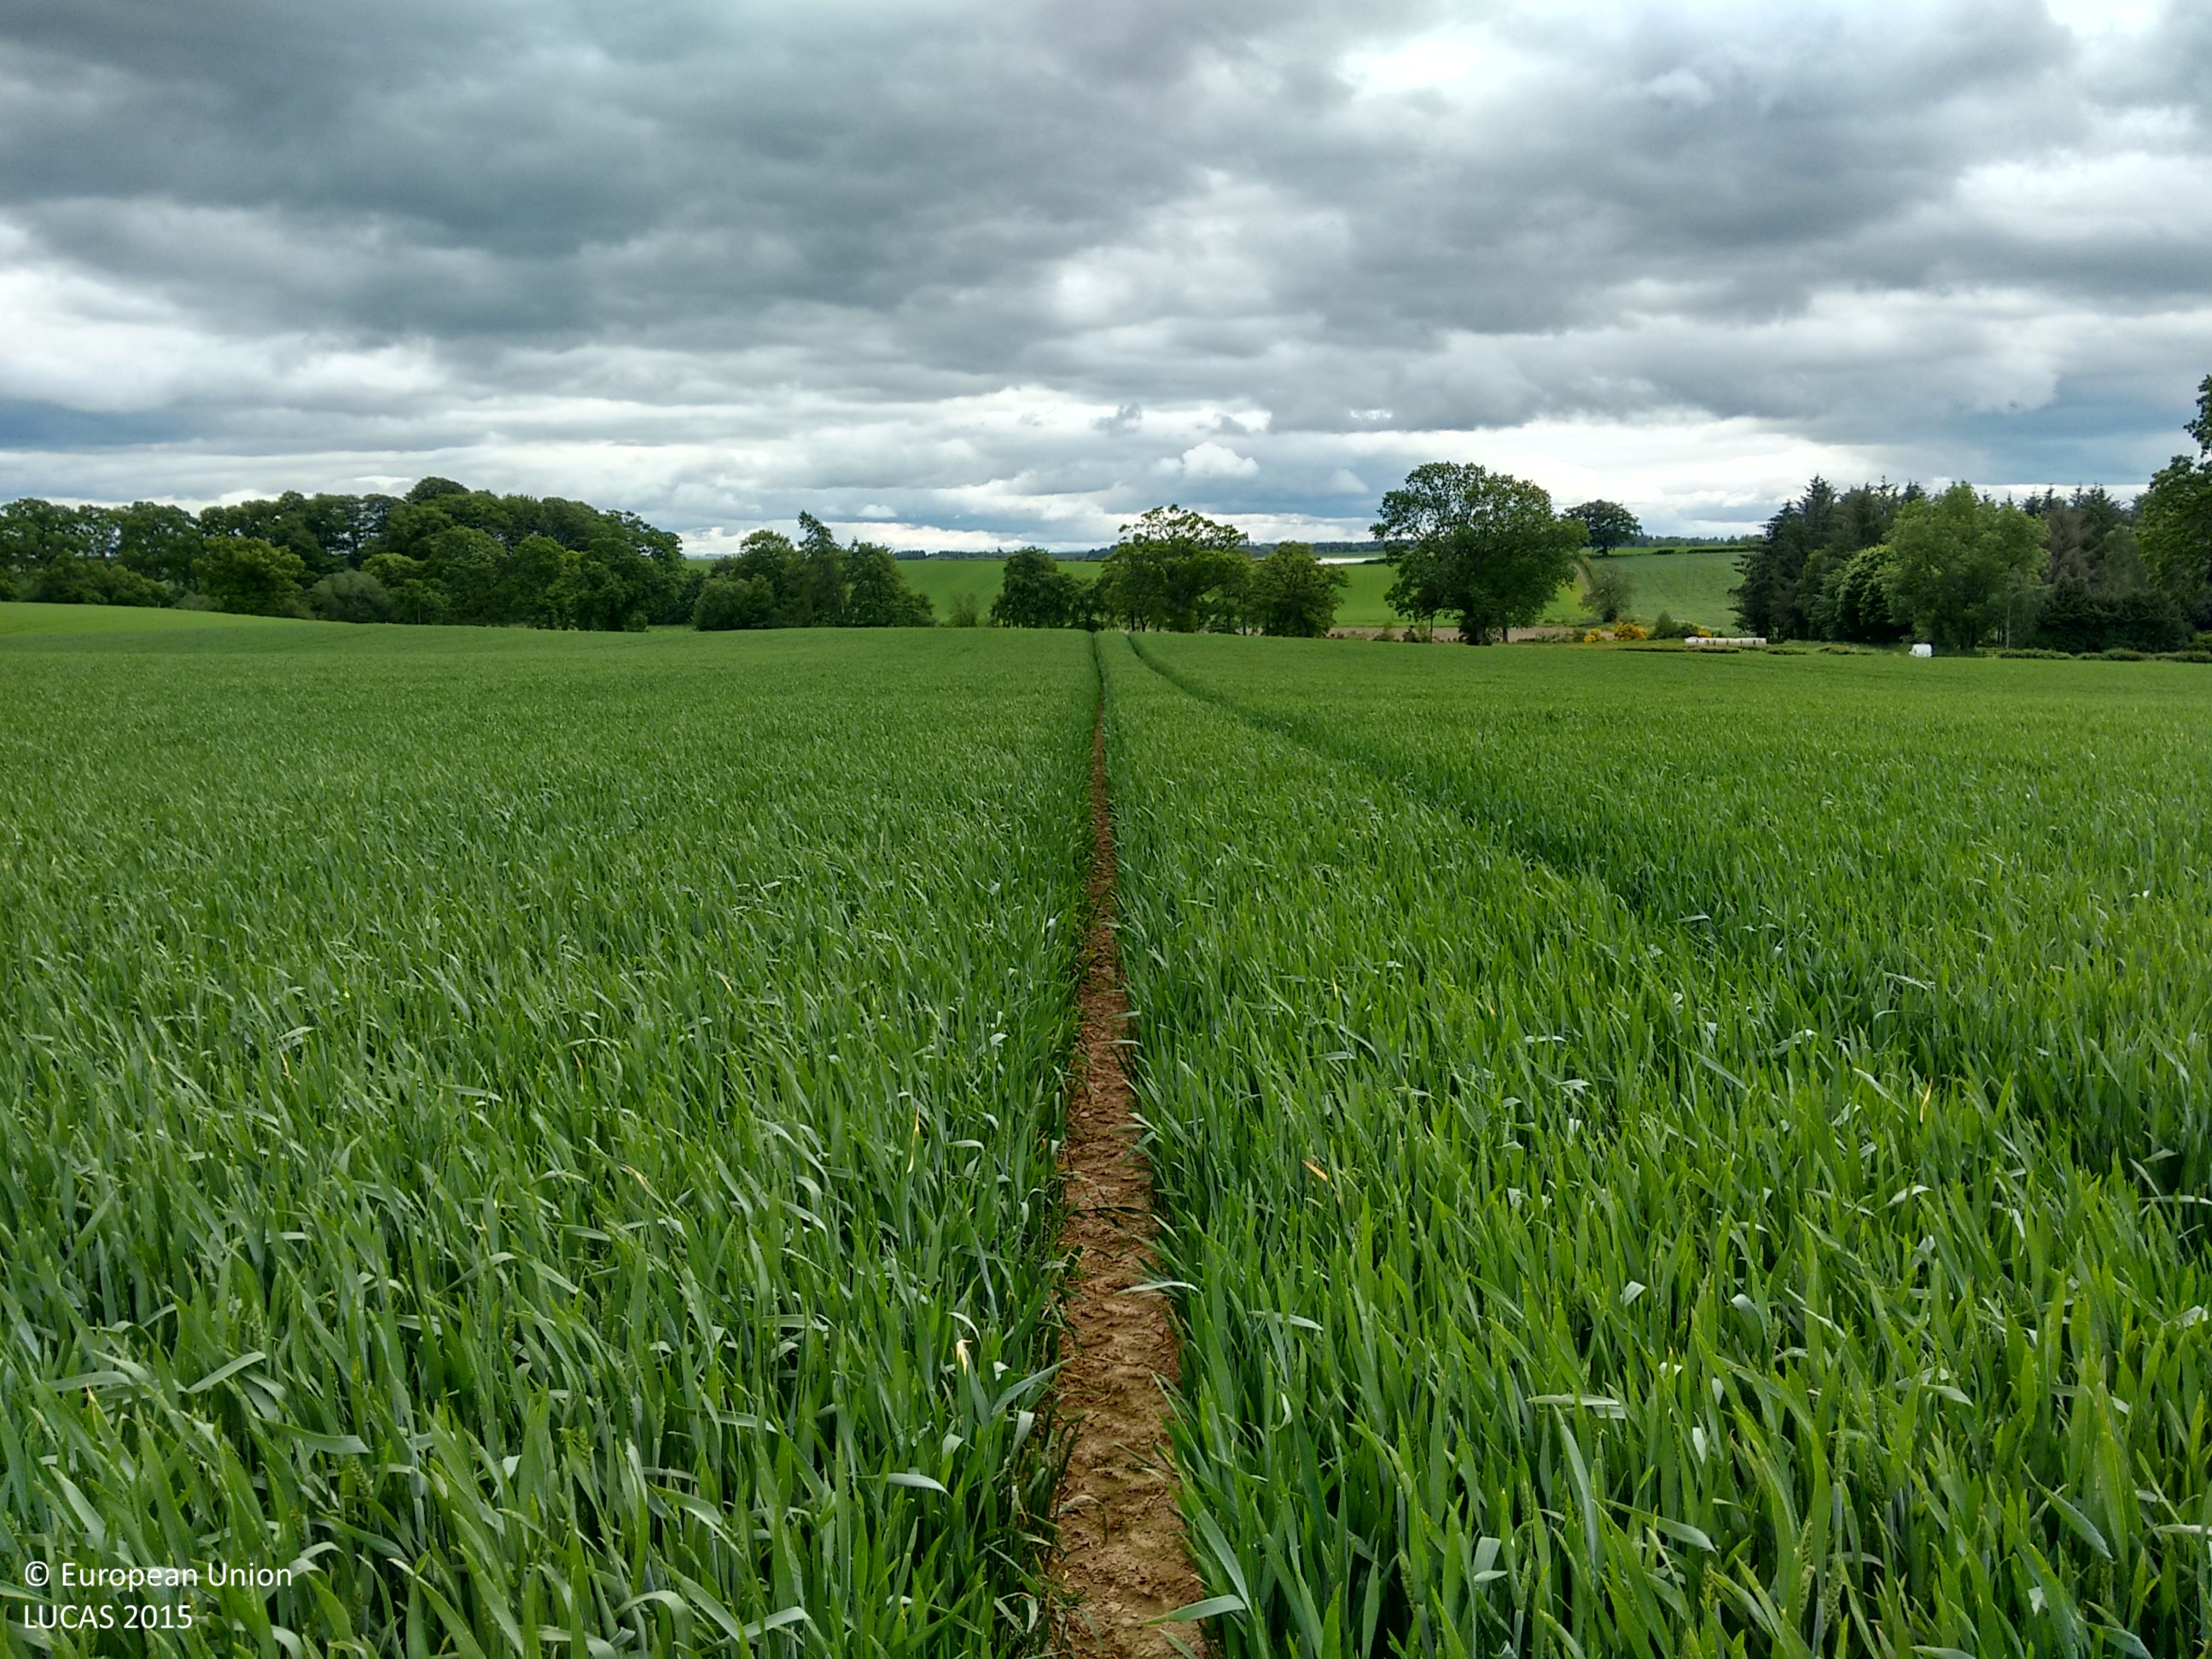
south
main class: Cropland
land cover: Common wheat
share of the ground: > 75 %
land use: Agriculture (excluding fallow land and kitchen gardens)
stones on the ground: 25 - 50 %
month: June
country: GB
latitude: 56.5061
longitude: -3.5455
